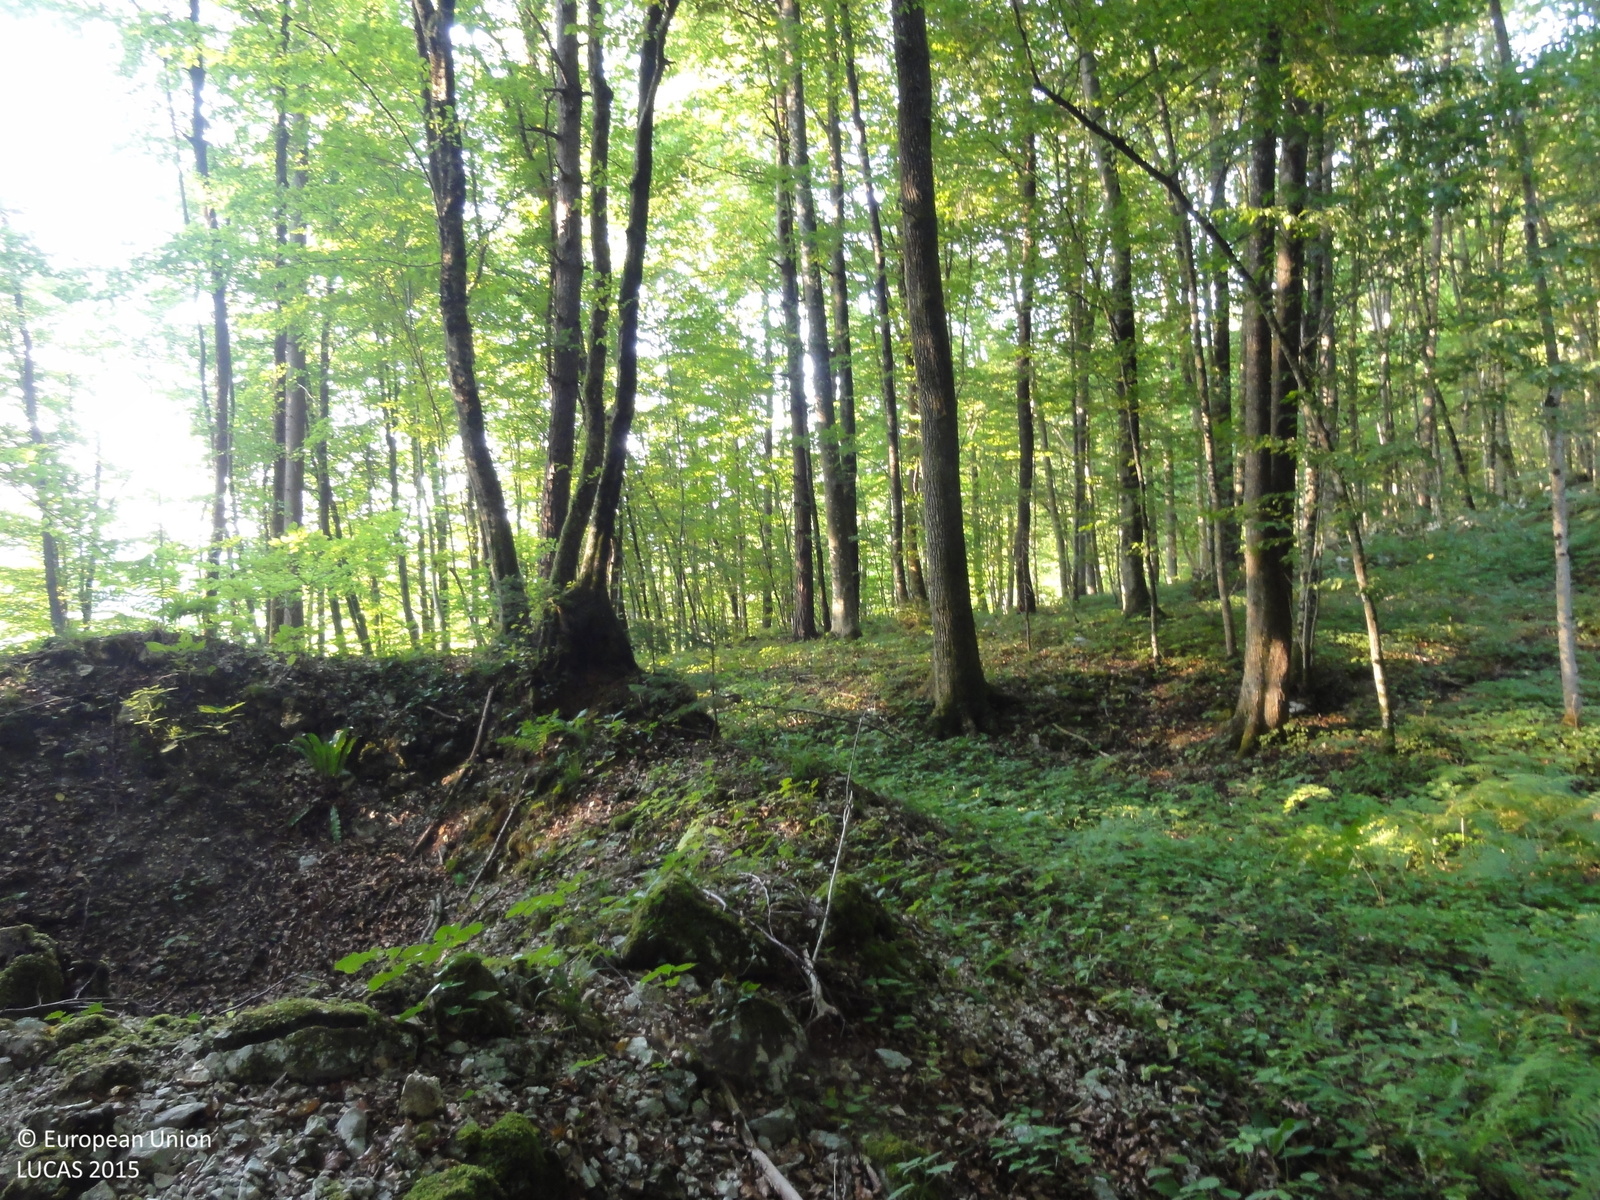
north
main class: Woodland
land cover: Broadleaved woodland
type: beech forest
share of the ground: > 75 %
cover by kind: broadleaved forest trees 95 %, coniferous forest trees 5 %
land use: Forestry
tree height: > 5 m
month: August
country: SI
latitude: 45.8370
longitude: 15.0047
